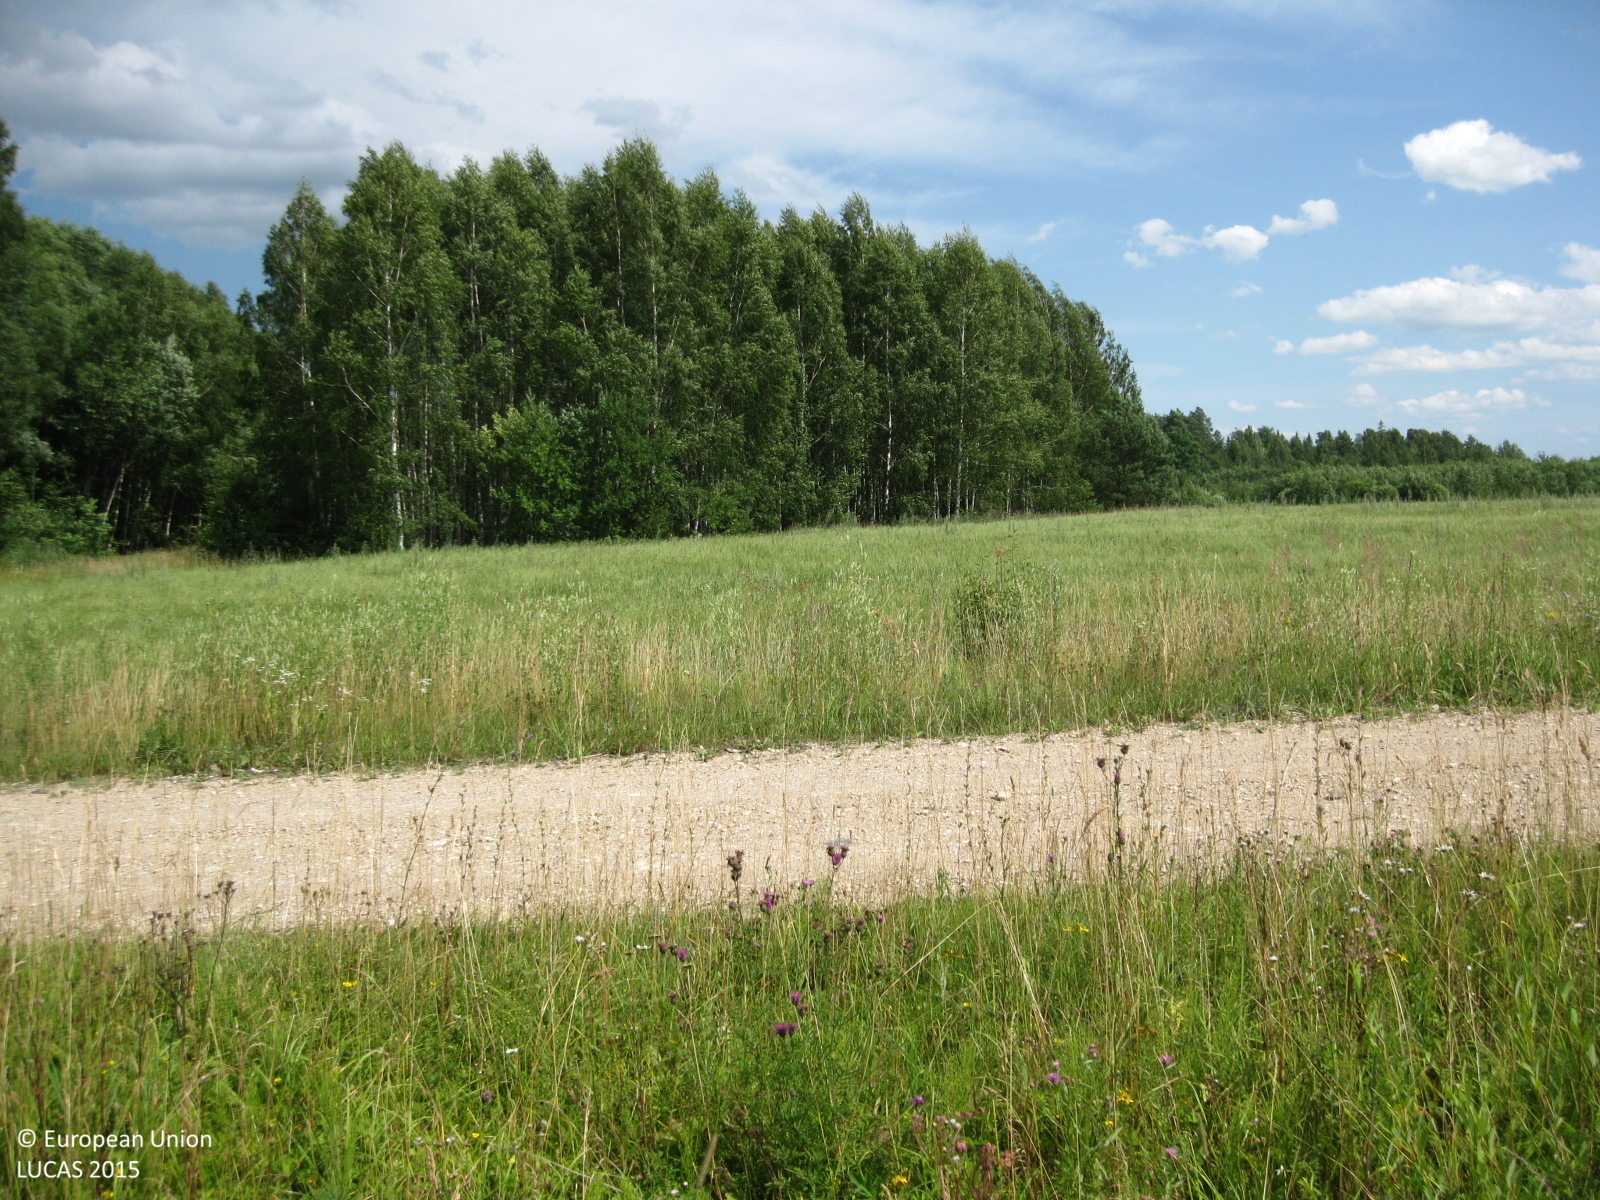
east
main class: Grassland
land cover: Grassland without tree/shrub cover
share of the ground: > 75 %
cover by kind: herbaceous plants 100 %
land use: Agriculture (excluding fallow land and kitchen gardens)
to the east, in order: Grassland without tree/shrub cover; Paved roads, cycling and walking lanes; Spontaneously vegetated surfaces; Barley; Broadleaved woodland; Other mixed woodland; Grassland without tree/shrub cover
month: July
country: LT
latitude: 55.0517
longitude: 24.6146
